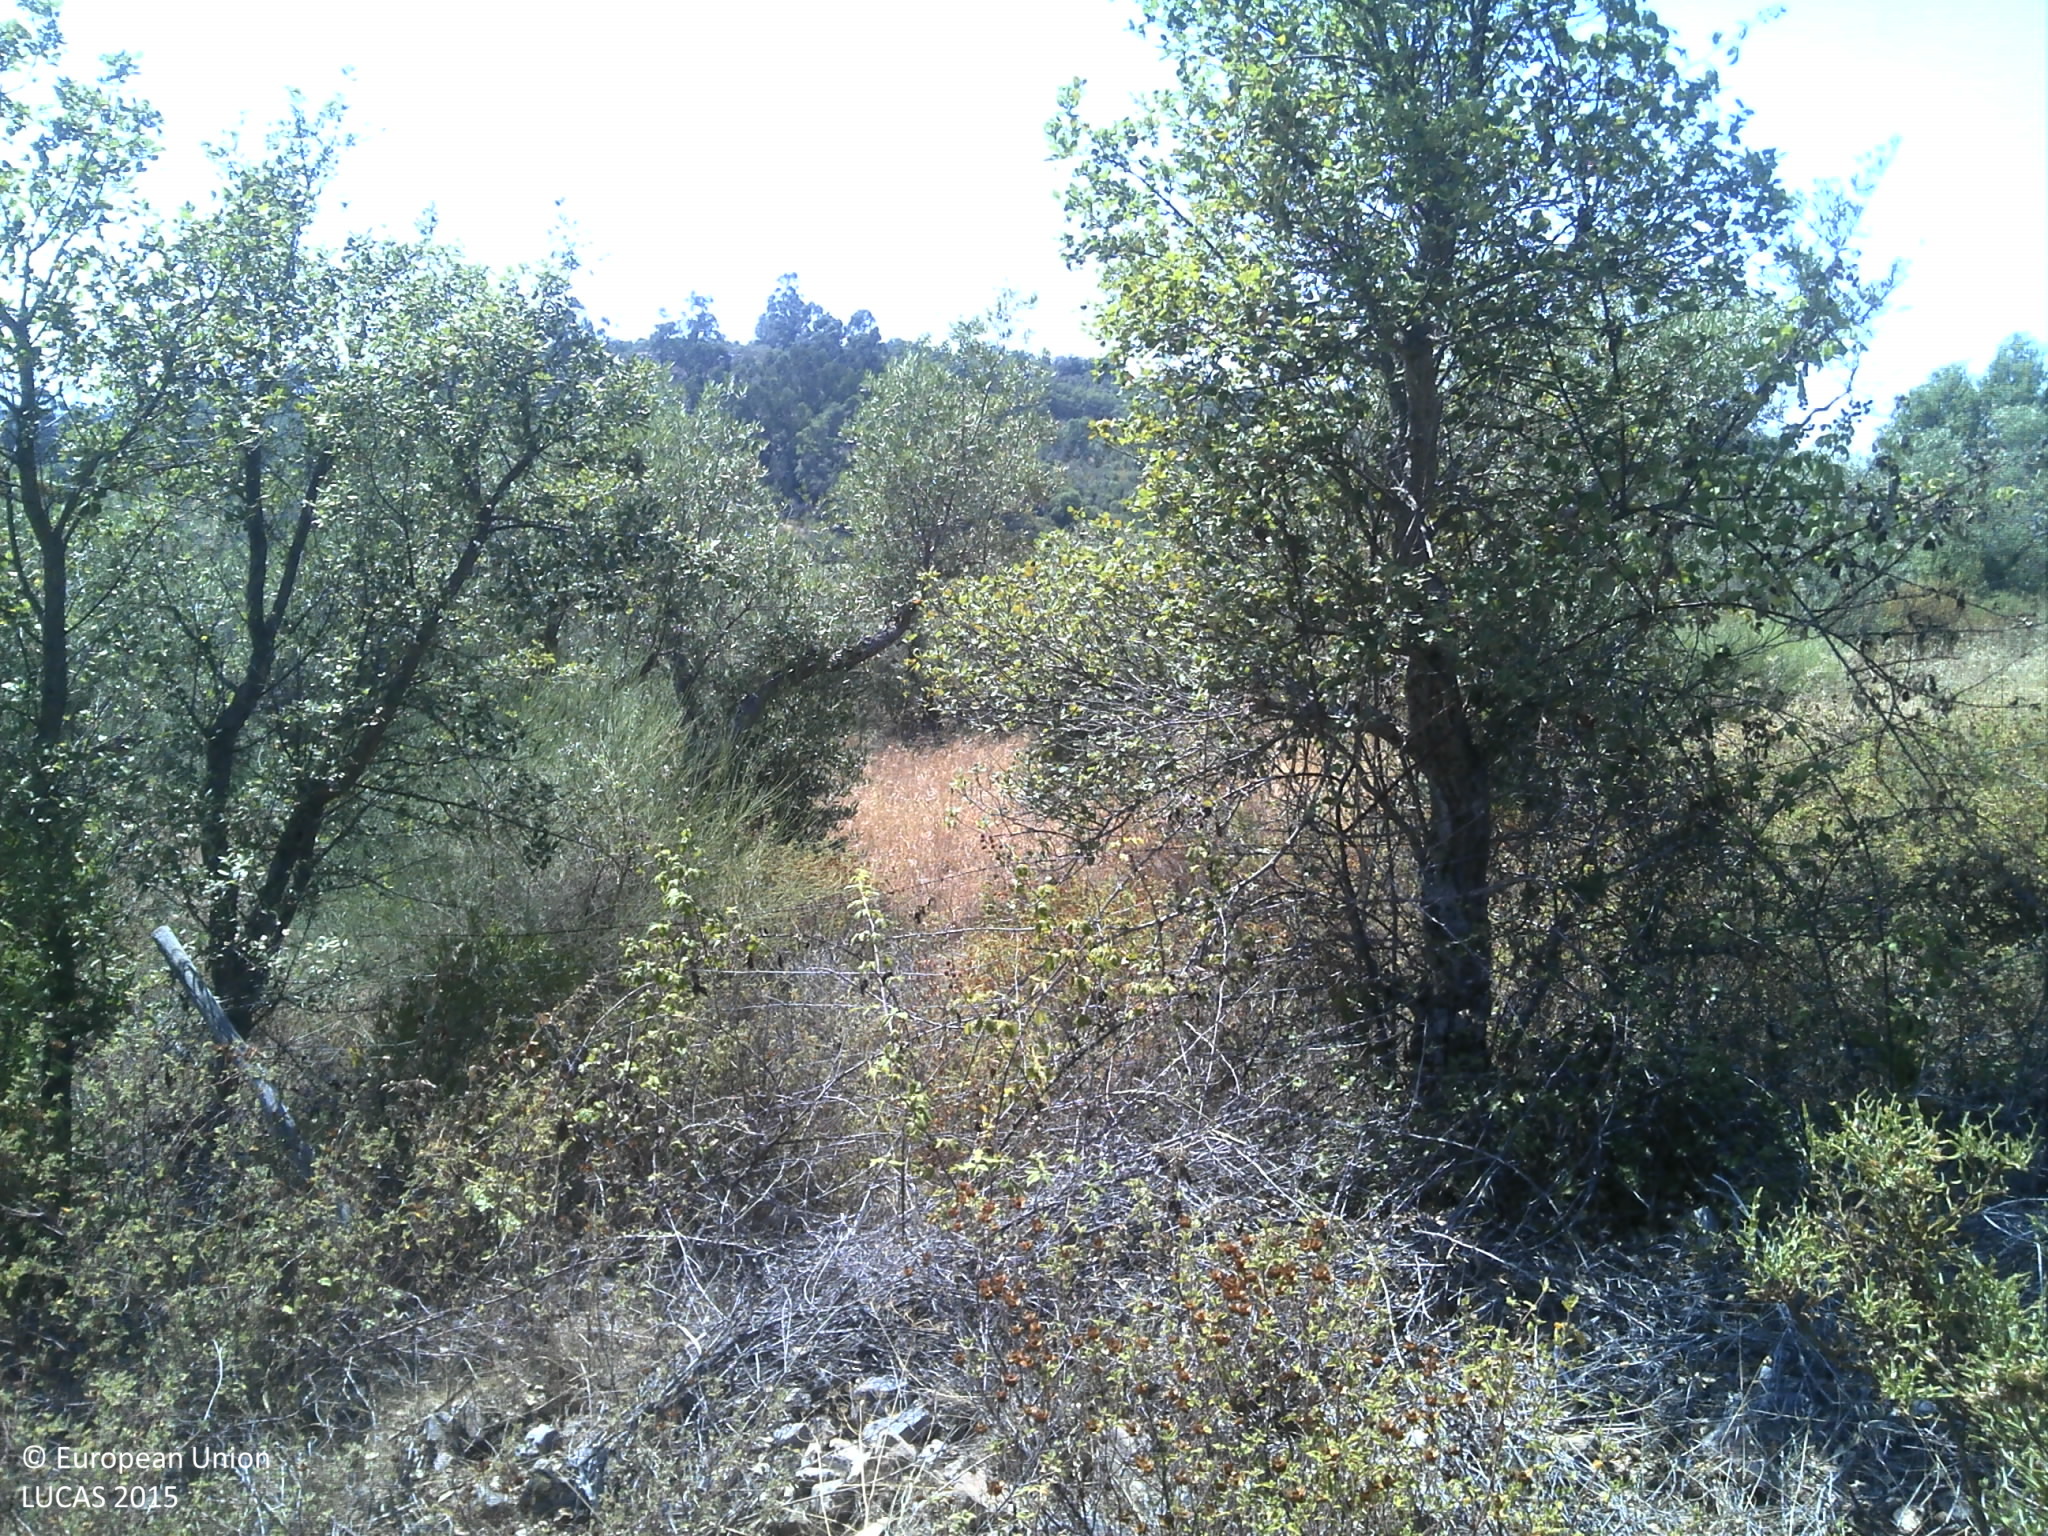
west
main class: Woodland
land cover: Broadleaved woodland
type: thermophilous deciduous forest
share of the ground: 50 - 75 %
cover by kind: broadleaved forest trees 60 %, shrubs 25 %, herbaceous plants 5 %, unconsolidated bare surface 5 %
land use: Forestry
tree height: > 5 m
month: June
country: PT
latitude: 39.7317
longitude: -7.3027
